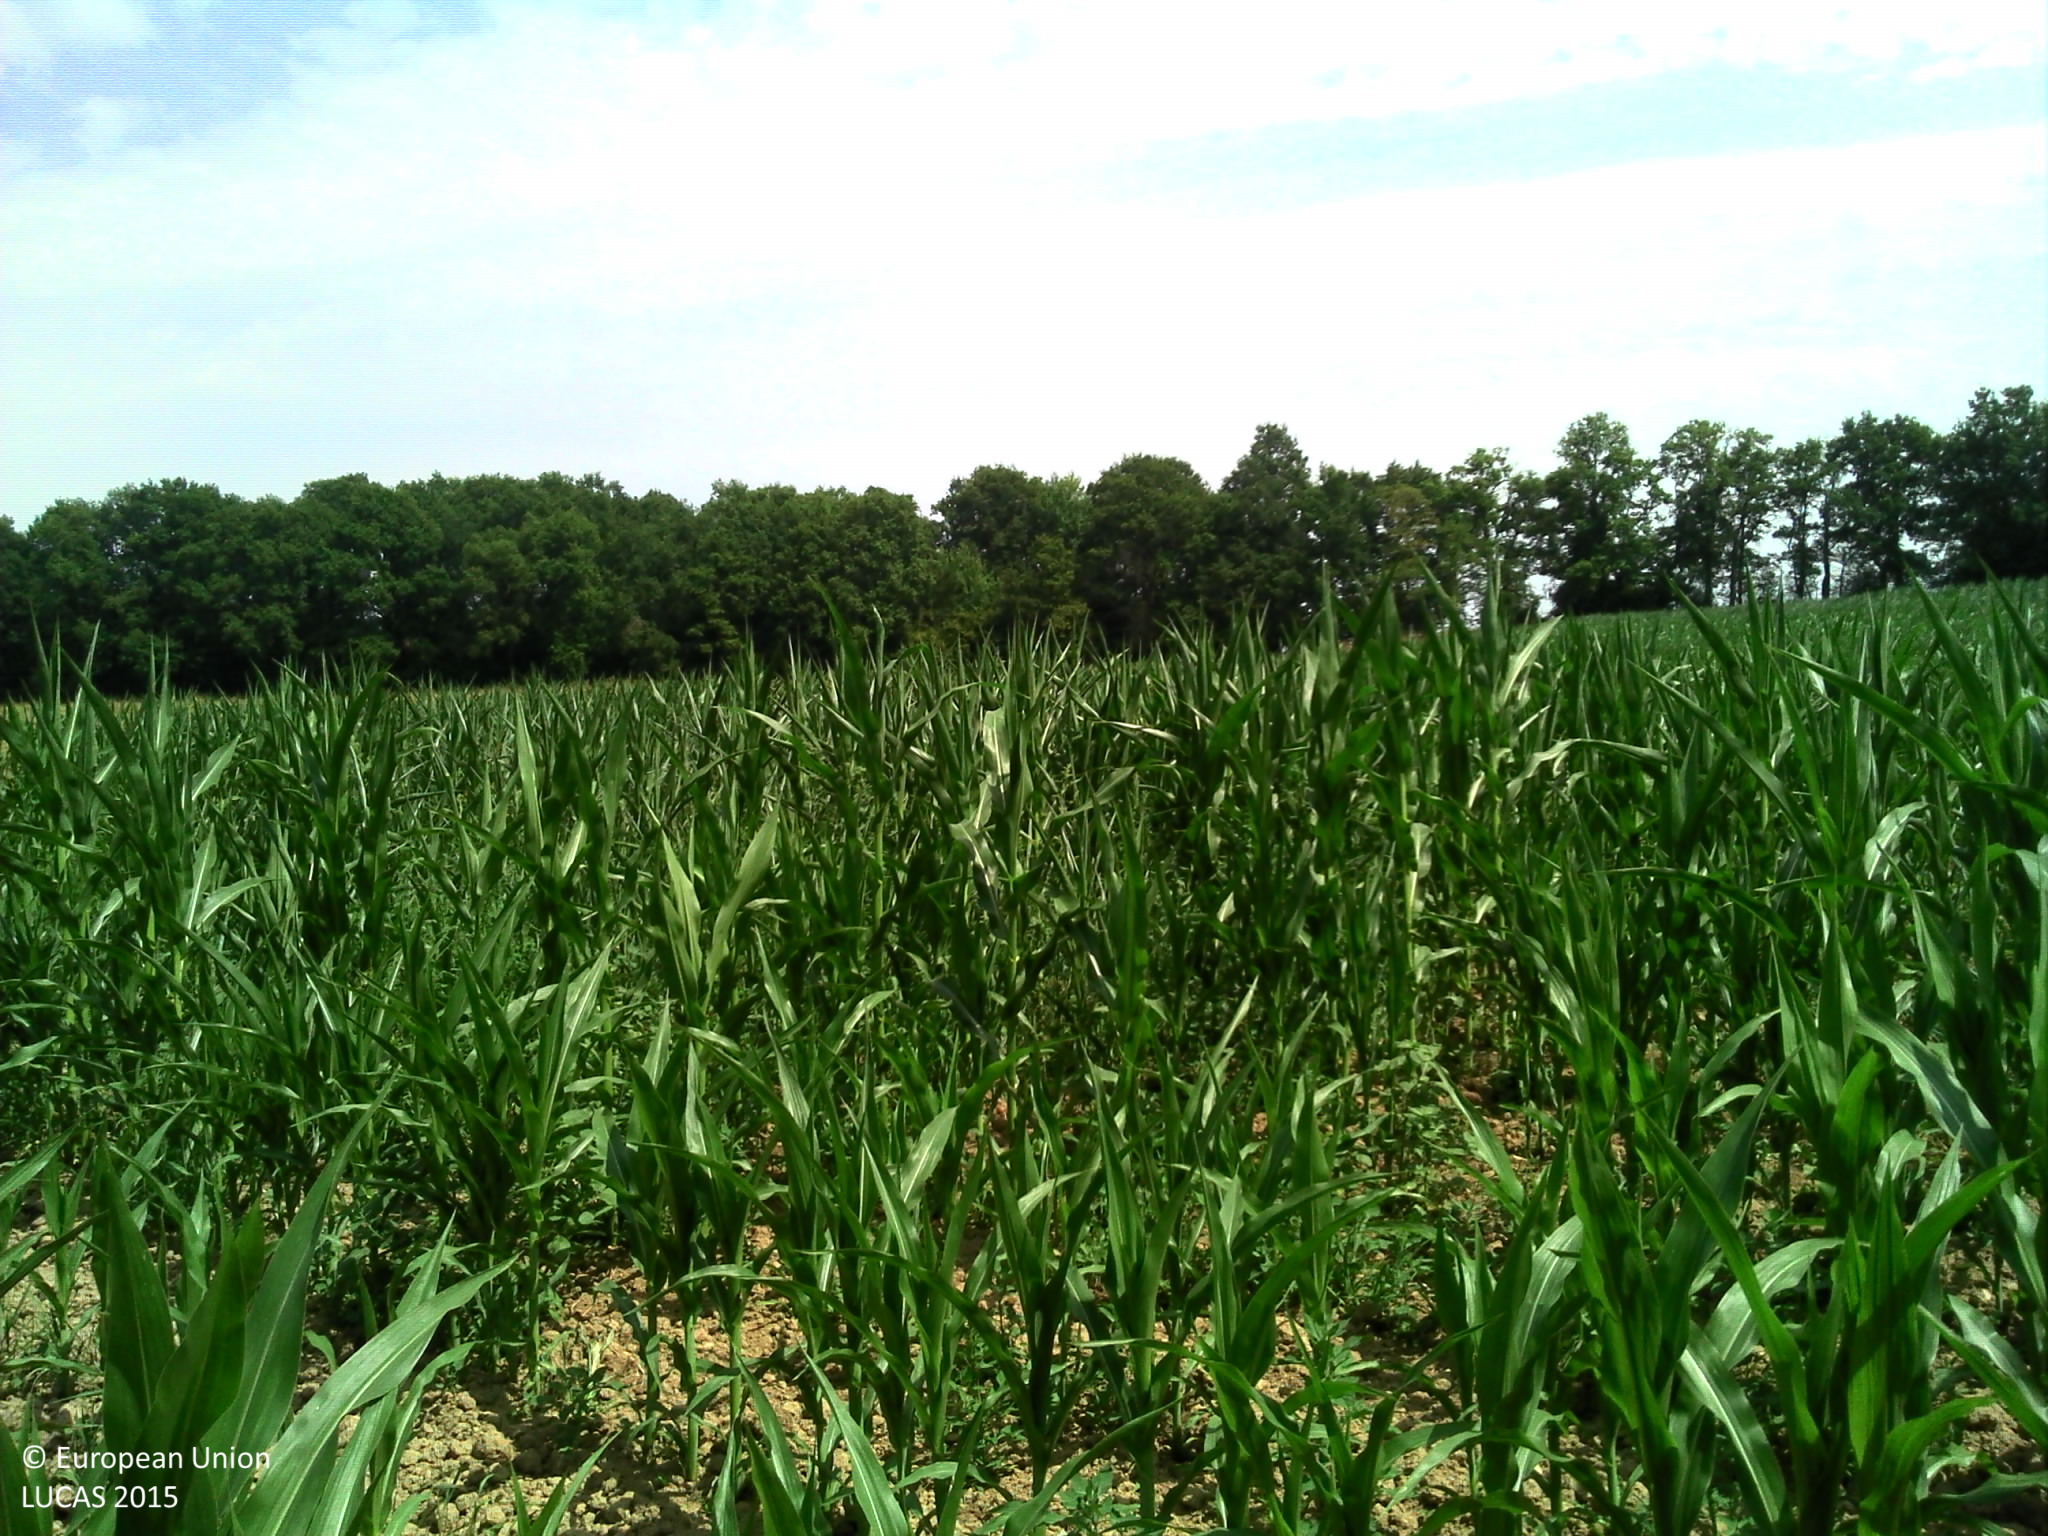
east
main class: Cropland
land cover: Maize
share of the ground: > 75 %
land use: Agriculture (excluding fallow land and kitchen gardens)
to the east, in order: Maize; Fences; Grassland without tree/shrub cover; Fences; Grassland without tree/shrub cover; Fences; Broadleaved woodland
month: July
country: FR
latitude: 45.7204
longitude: 1.0348
